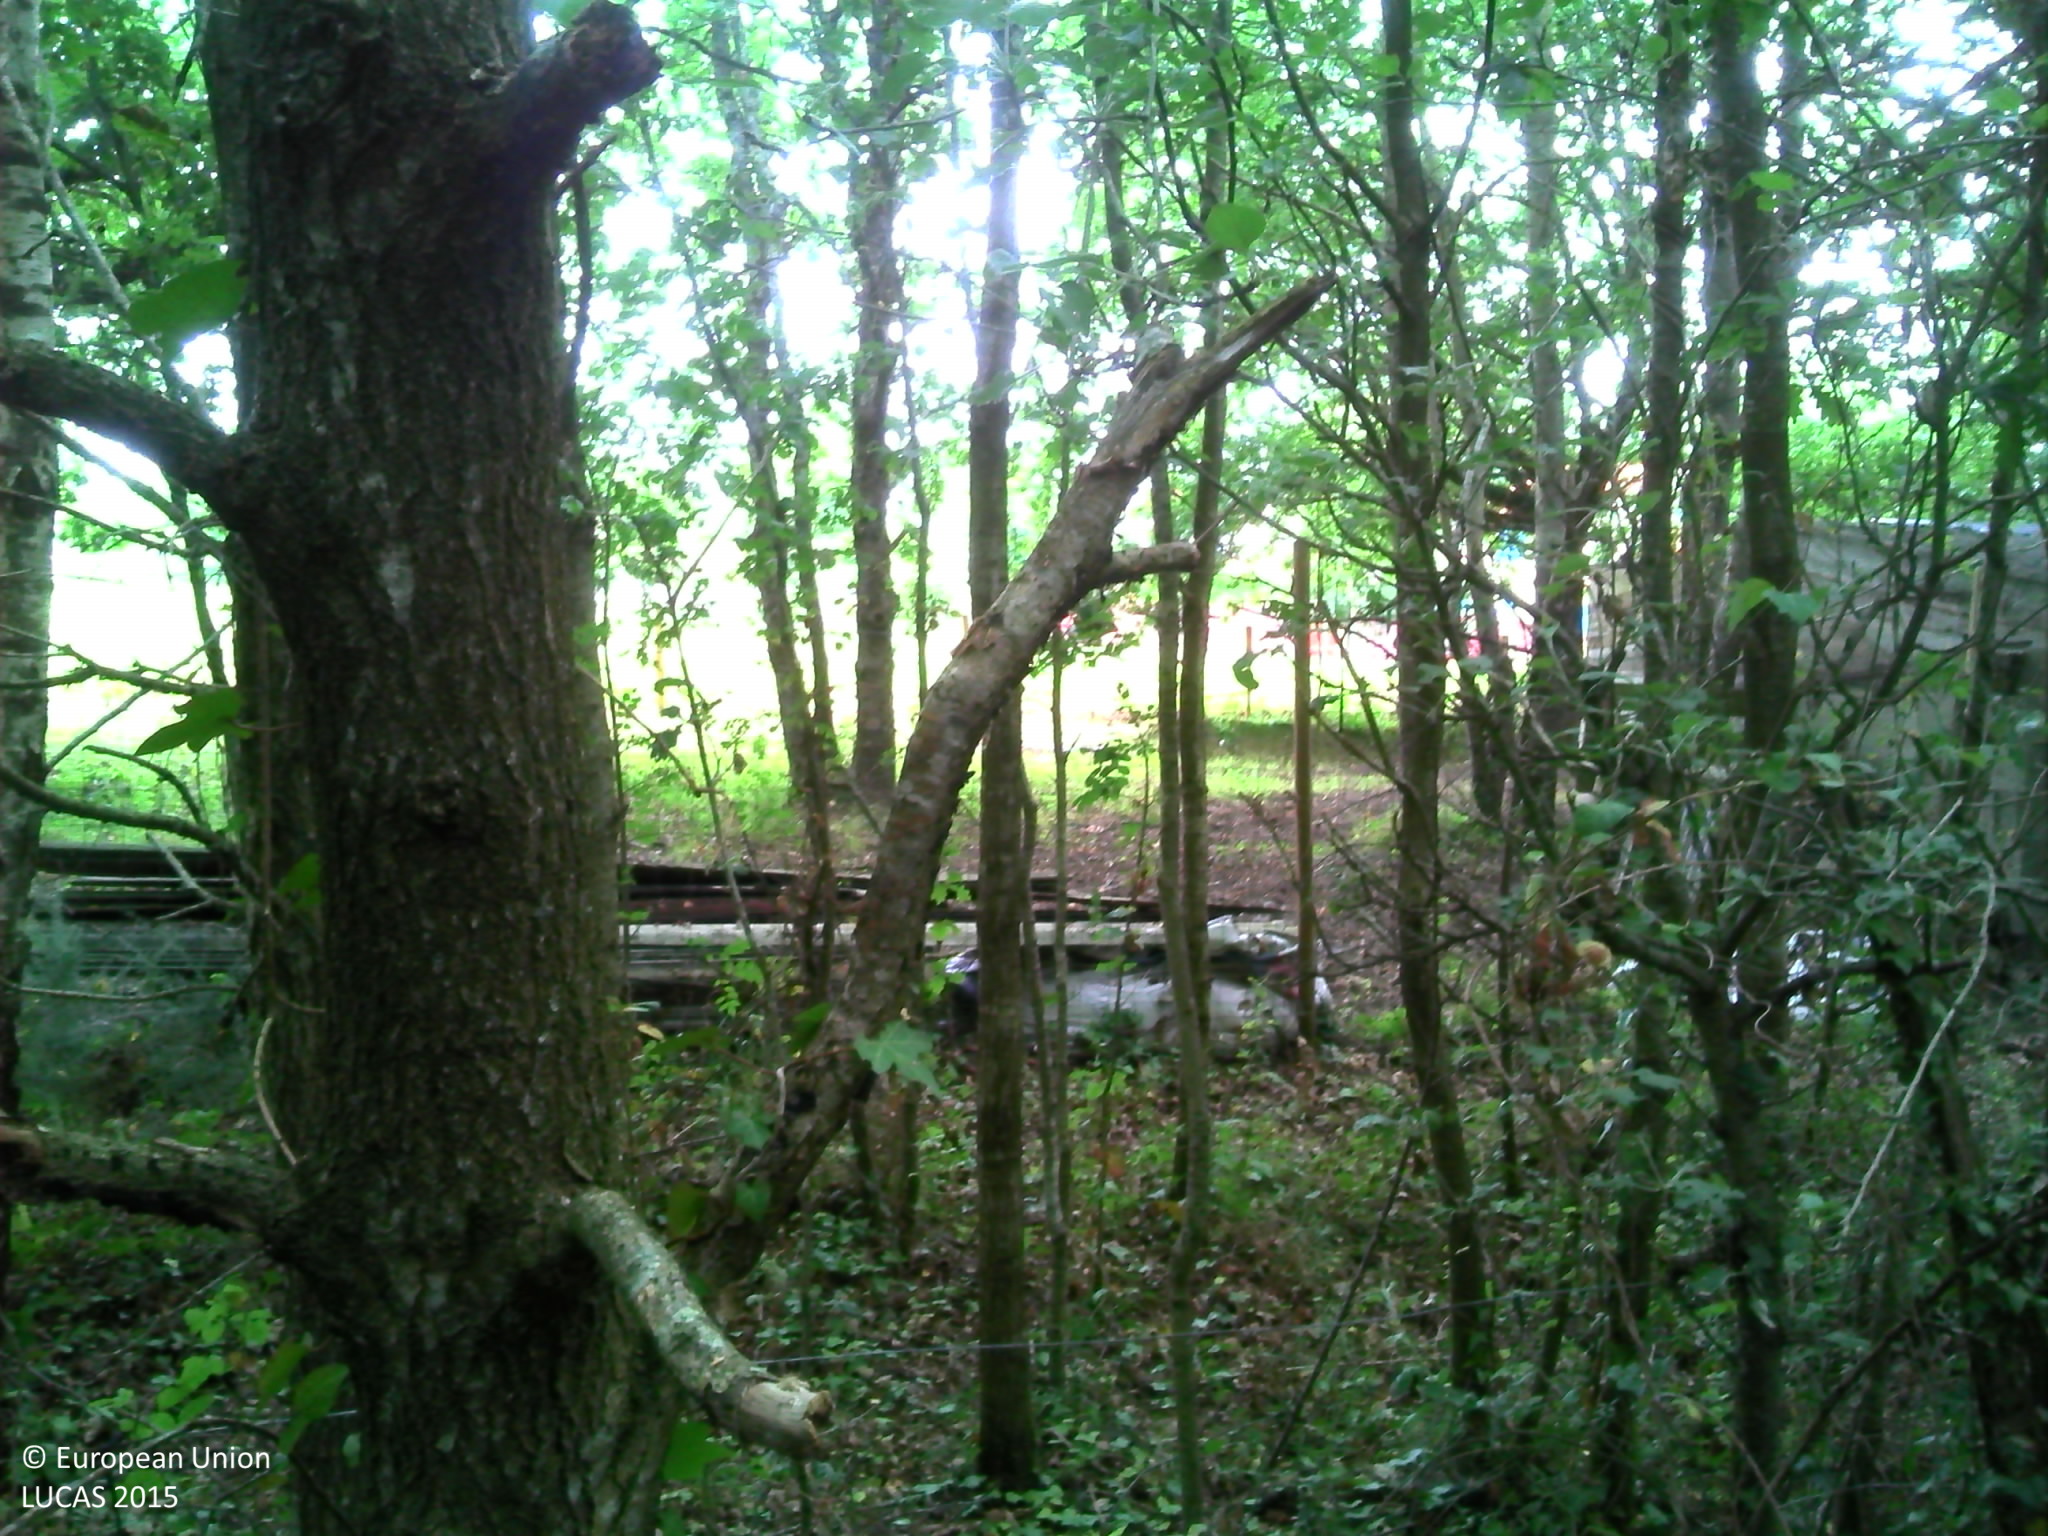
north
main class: Woodland
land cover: Broadleaved woodland
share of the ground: > 75 %
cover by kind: broadleaved forest trees 95 %, herbaceous plants 5 %
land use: Semi-natural and natural areas not in use
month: July
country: FR
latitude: 47.1215
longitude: -1.7356
